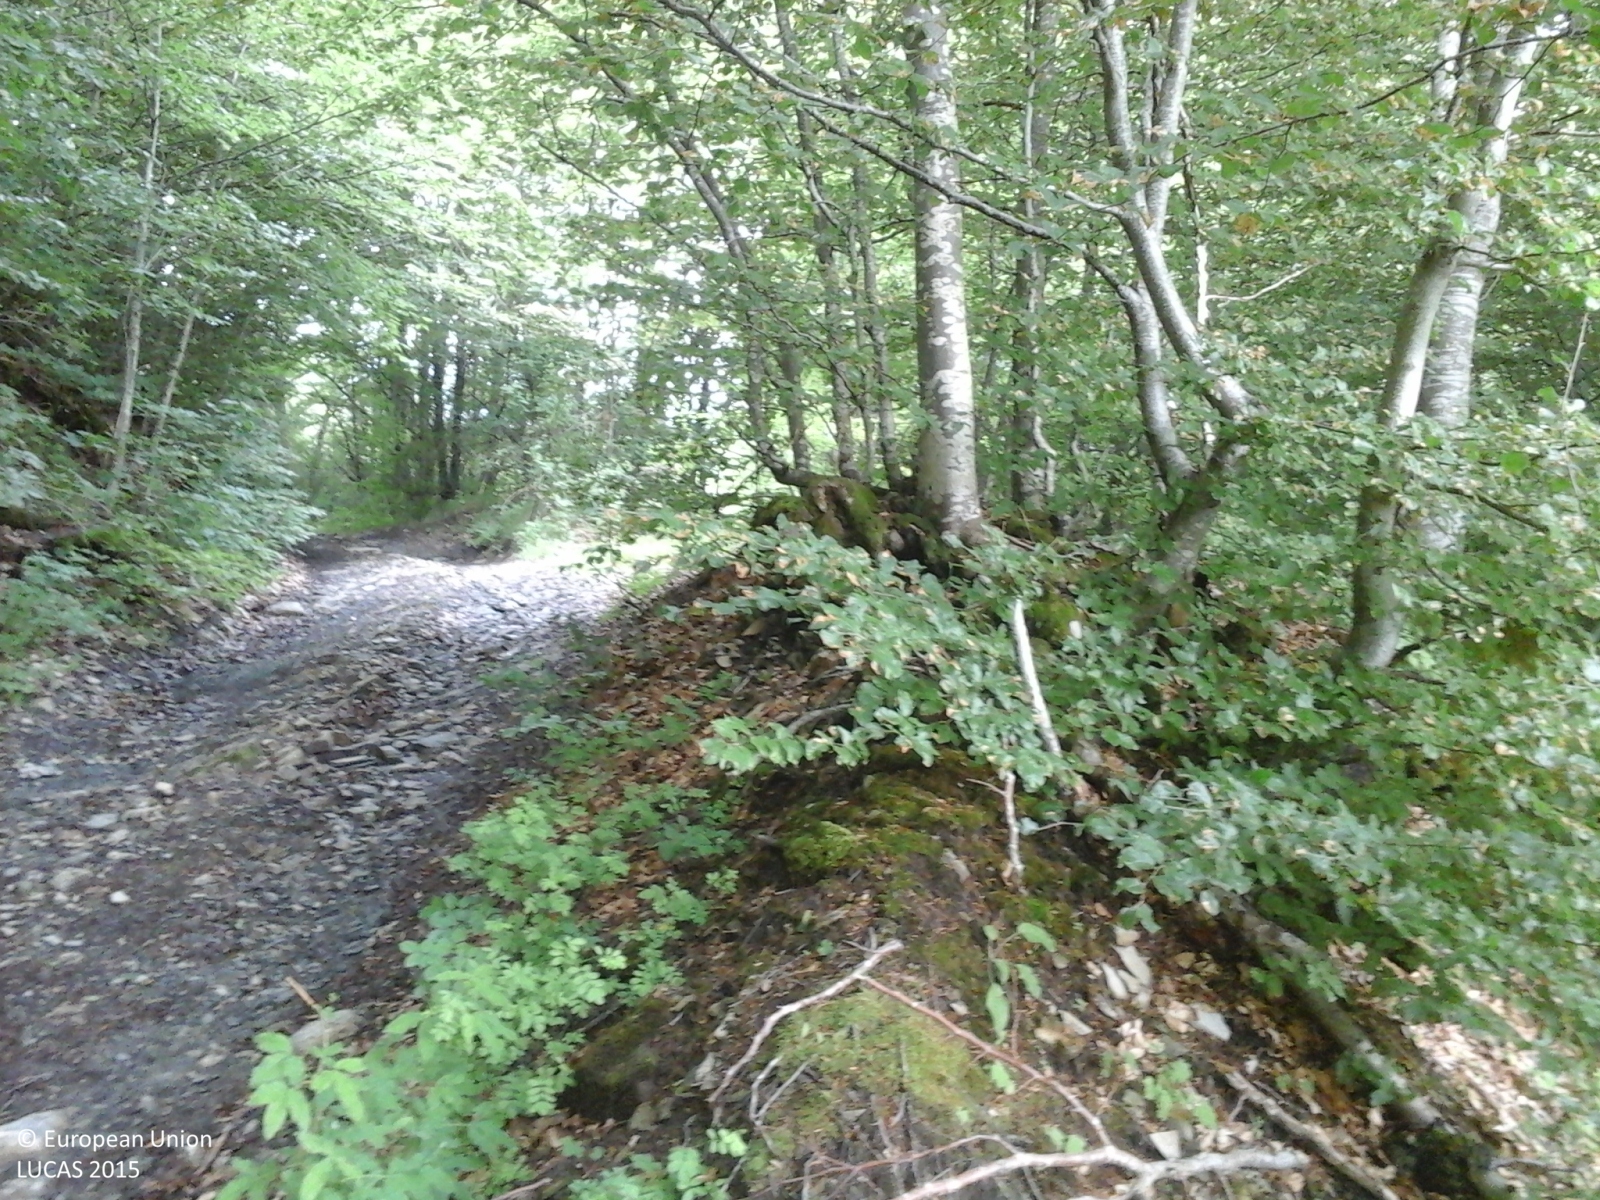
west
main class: Woodland
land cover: Broadleaved woodland
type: thermophilous deciduous forest
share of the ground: > 75 %
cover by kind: broadleaved forest trees 100 %
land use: Forestry
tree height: > 5 m
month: June
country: IT
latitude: 44.5660
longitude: 9.5603
